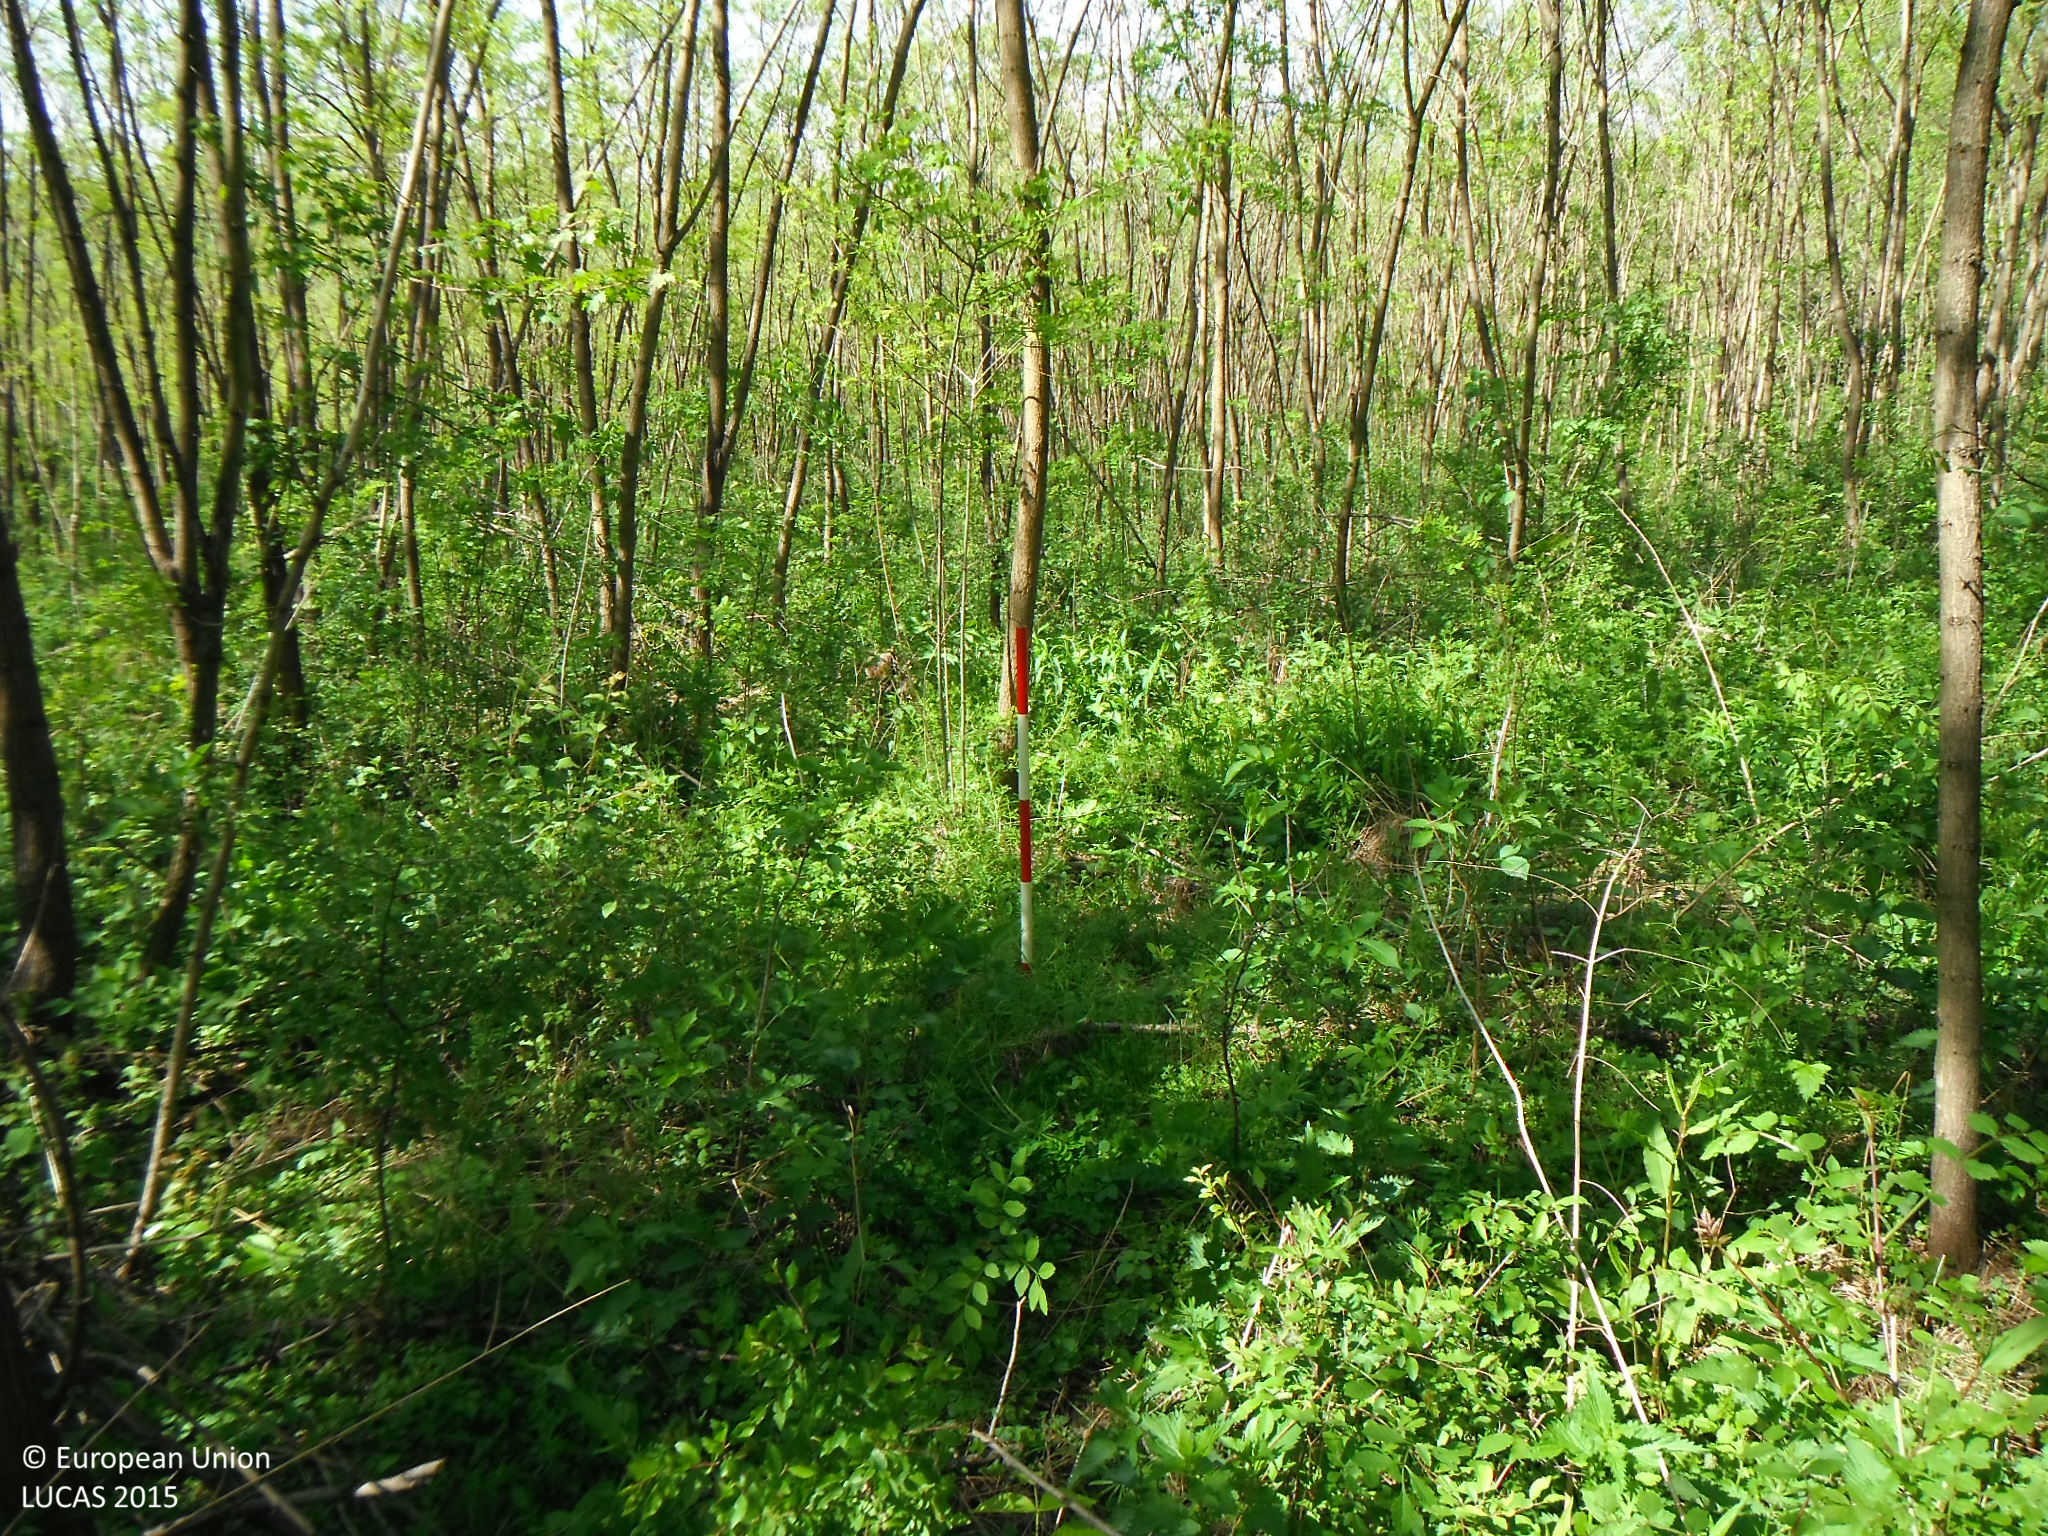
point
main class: Woodland
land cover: Broadleaved woodland
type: exotic forest
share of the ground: > 75 %
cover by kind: broadleaved forest trees 80 %, herbaceous plants 20 %
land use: Forestry
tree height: > 5 m
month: May
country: SK
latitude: 48.4940
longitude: 21.1250
